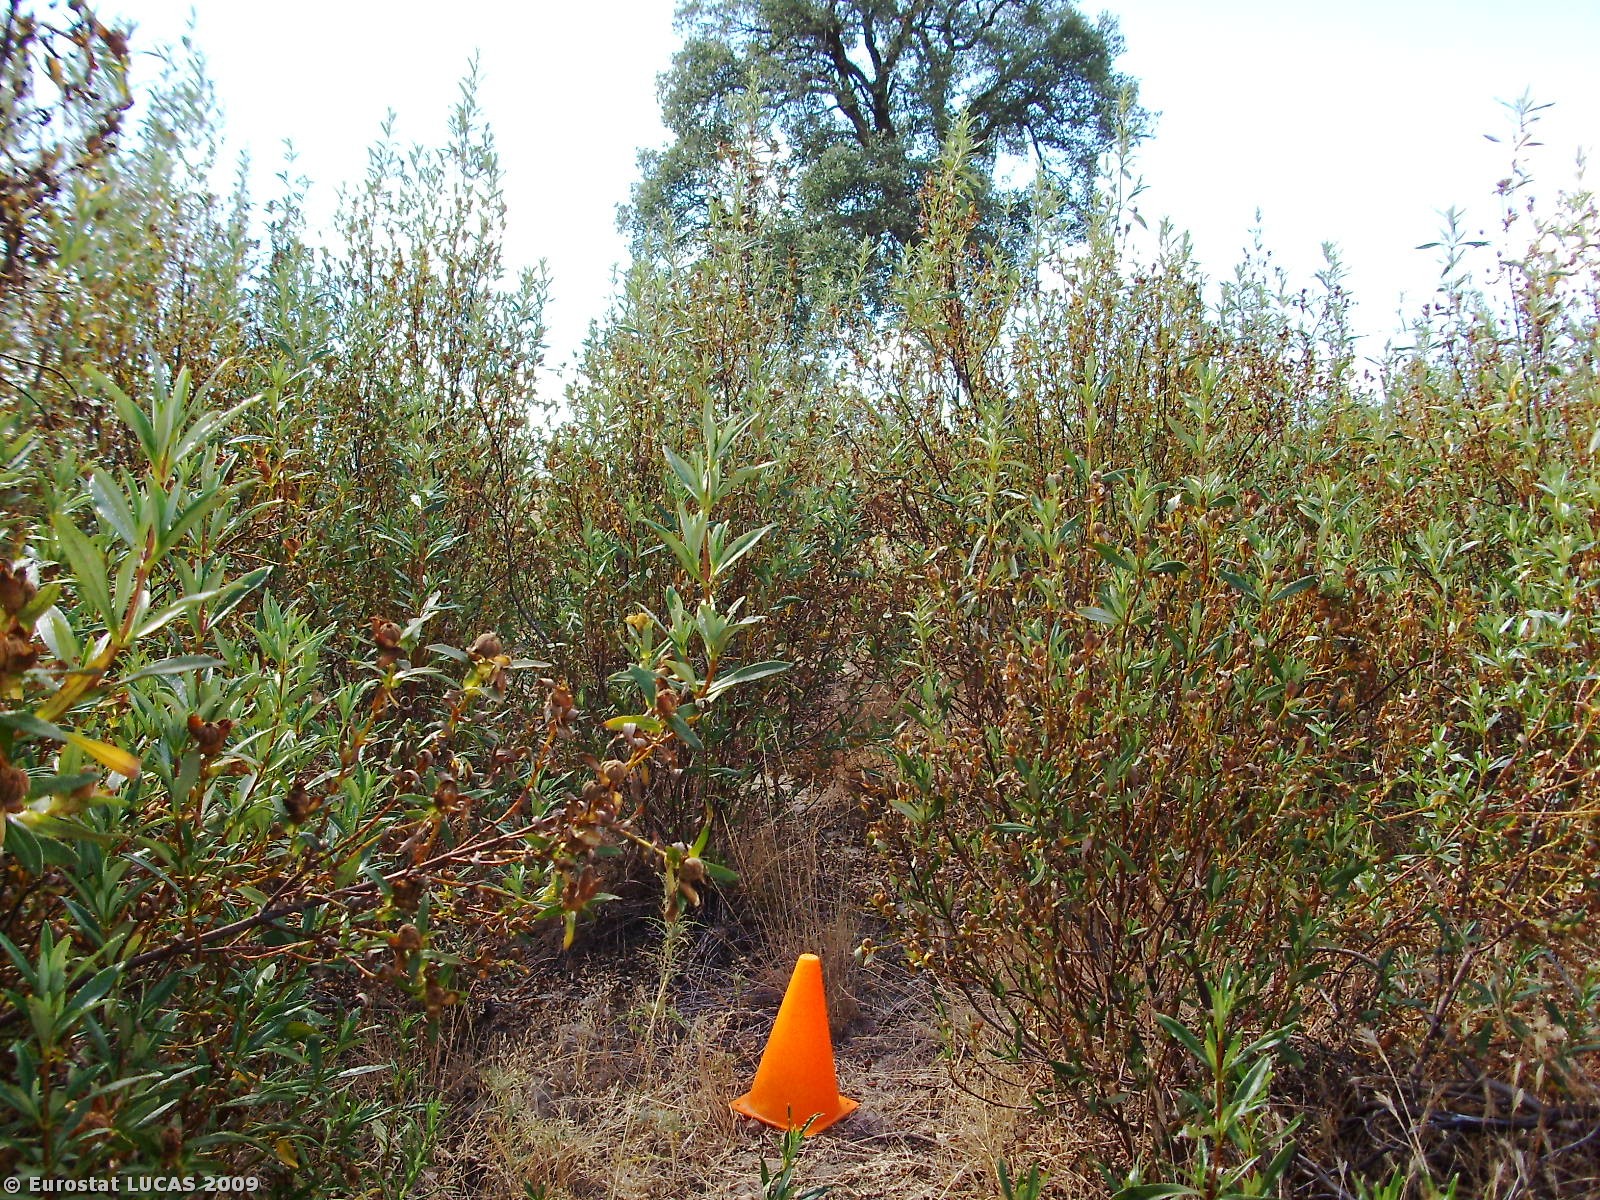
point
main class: Shrubland
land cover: Shrubland with sparse tree cover
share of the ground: > 75 %
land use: Fallow land
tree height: > 5 m
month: June
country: PT
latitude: 37.8371
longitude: -8.5276
